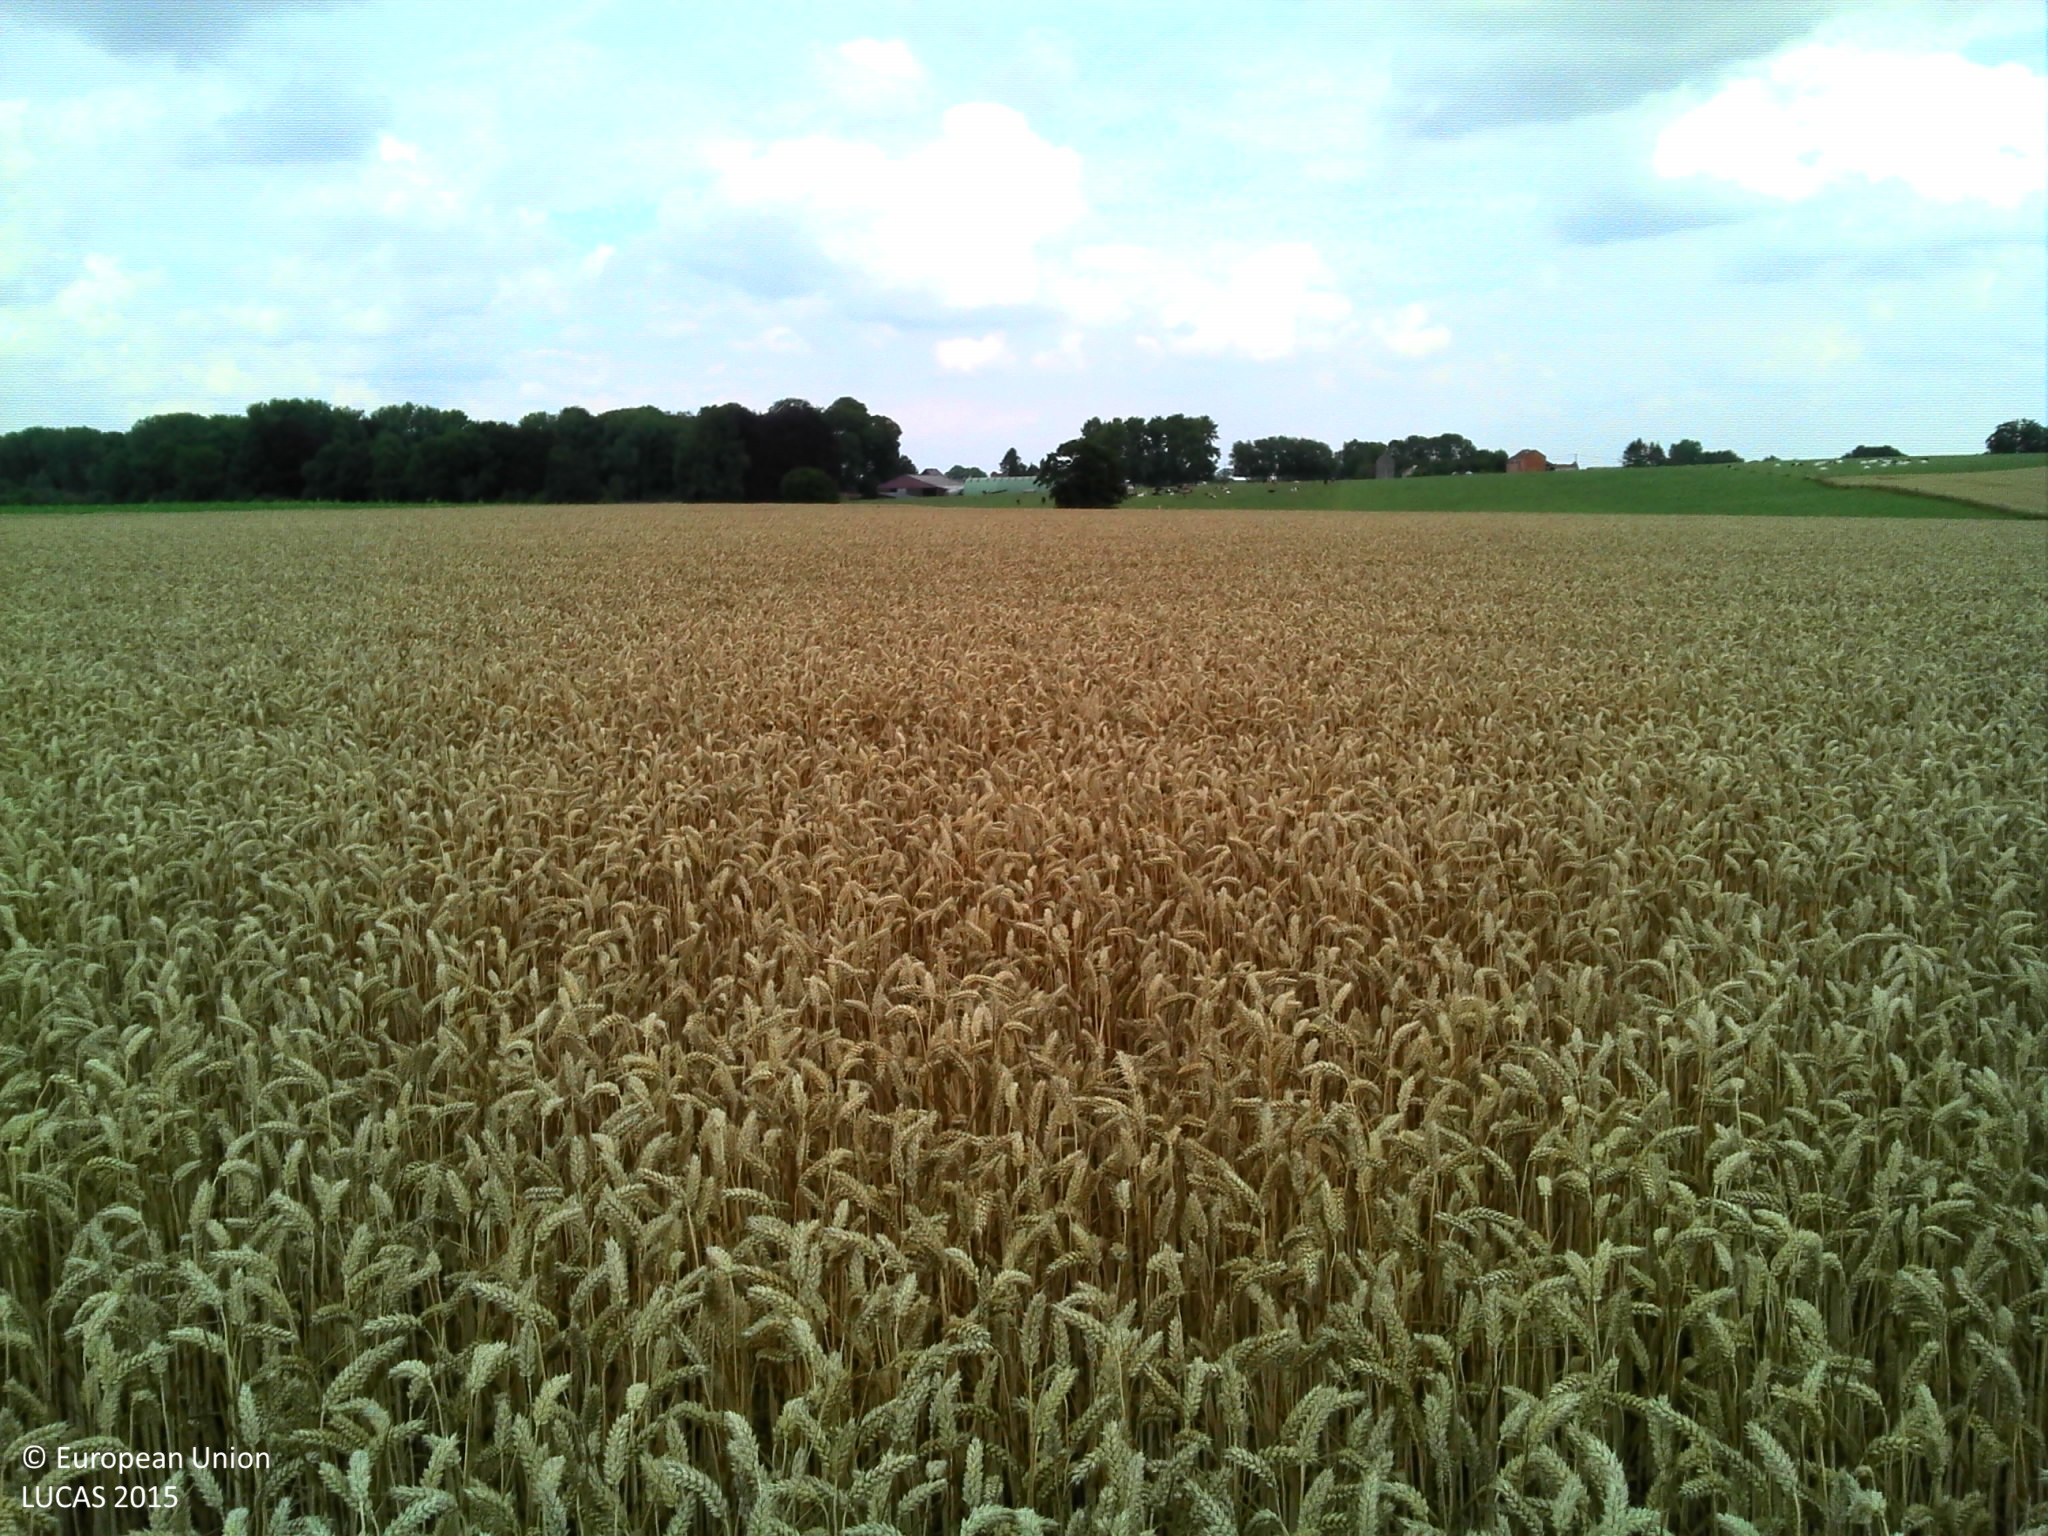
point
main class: Cropland
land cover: Common wheat
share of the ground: > 75 %
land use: Agriculture (excluding fallow land and kitchen gardens)
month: July
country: BE
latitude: 50.5661
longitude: 4.3340
